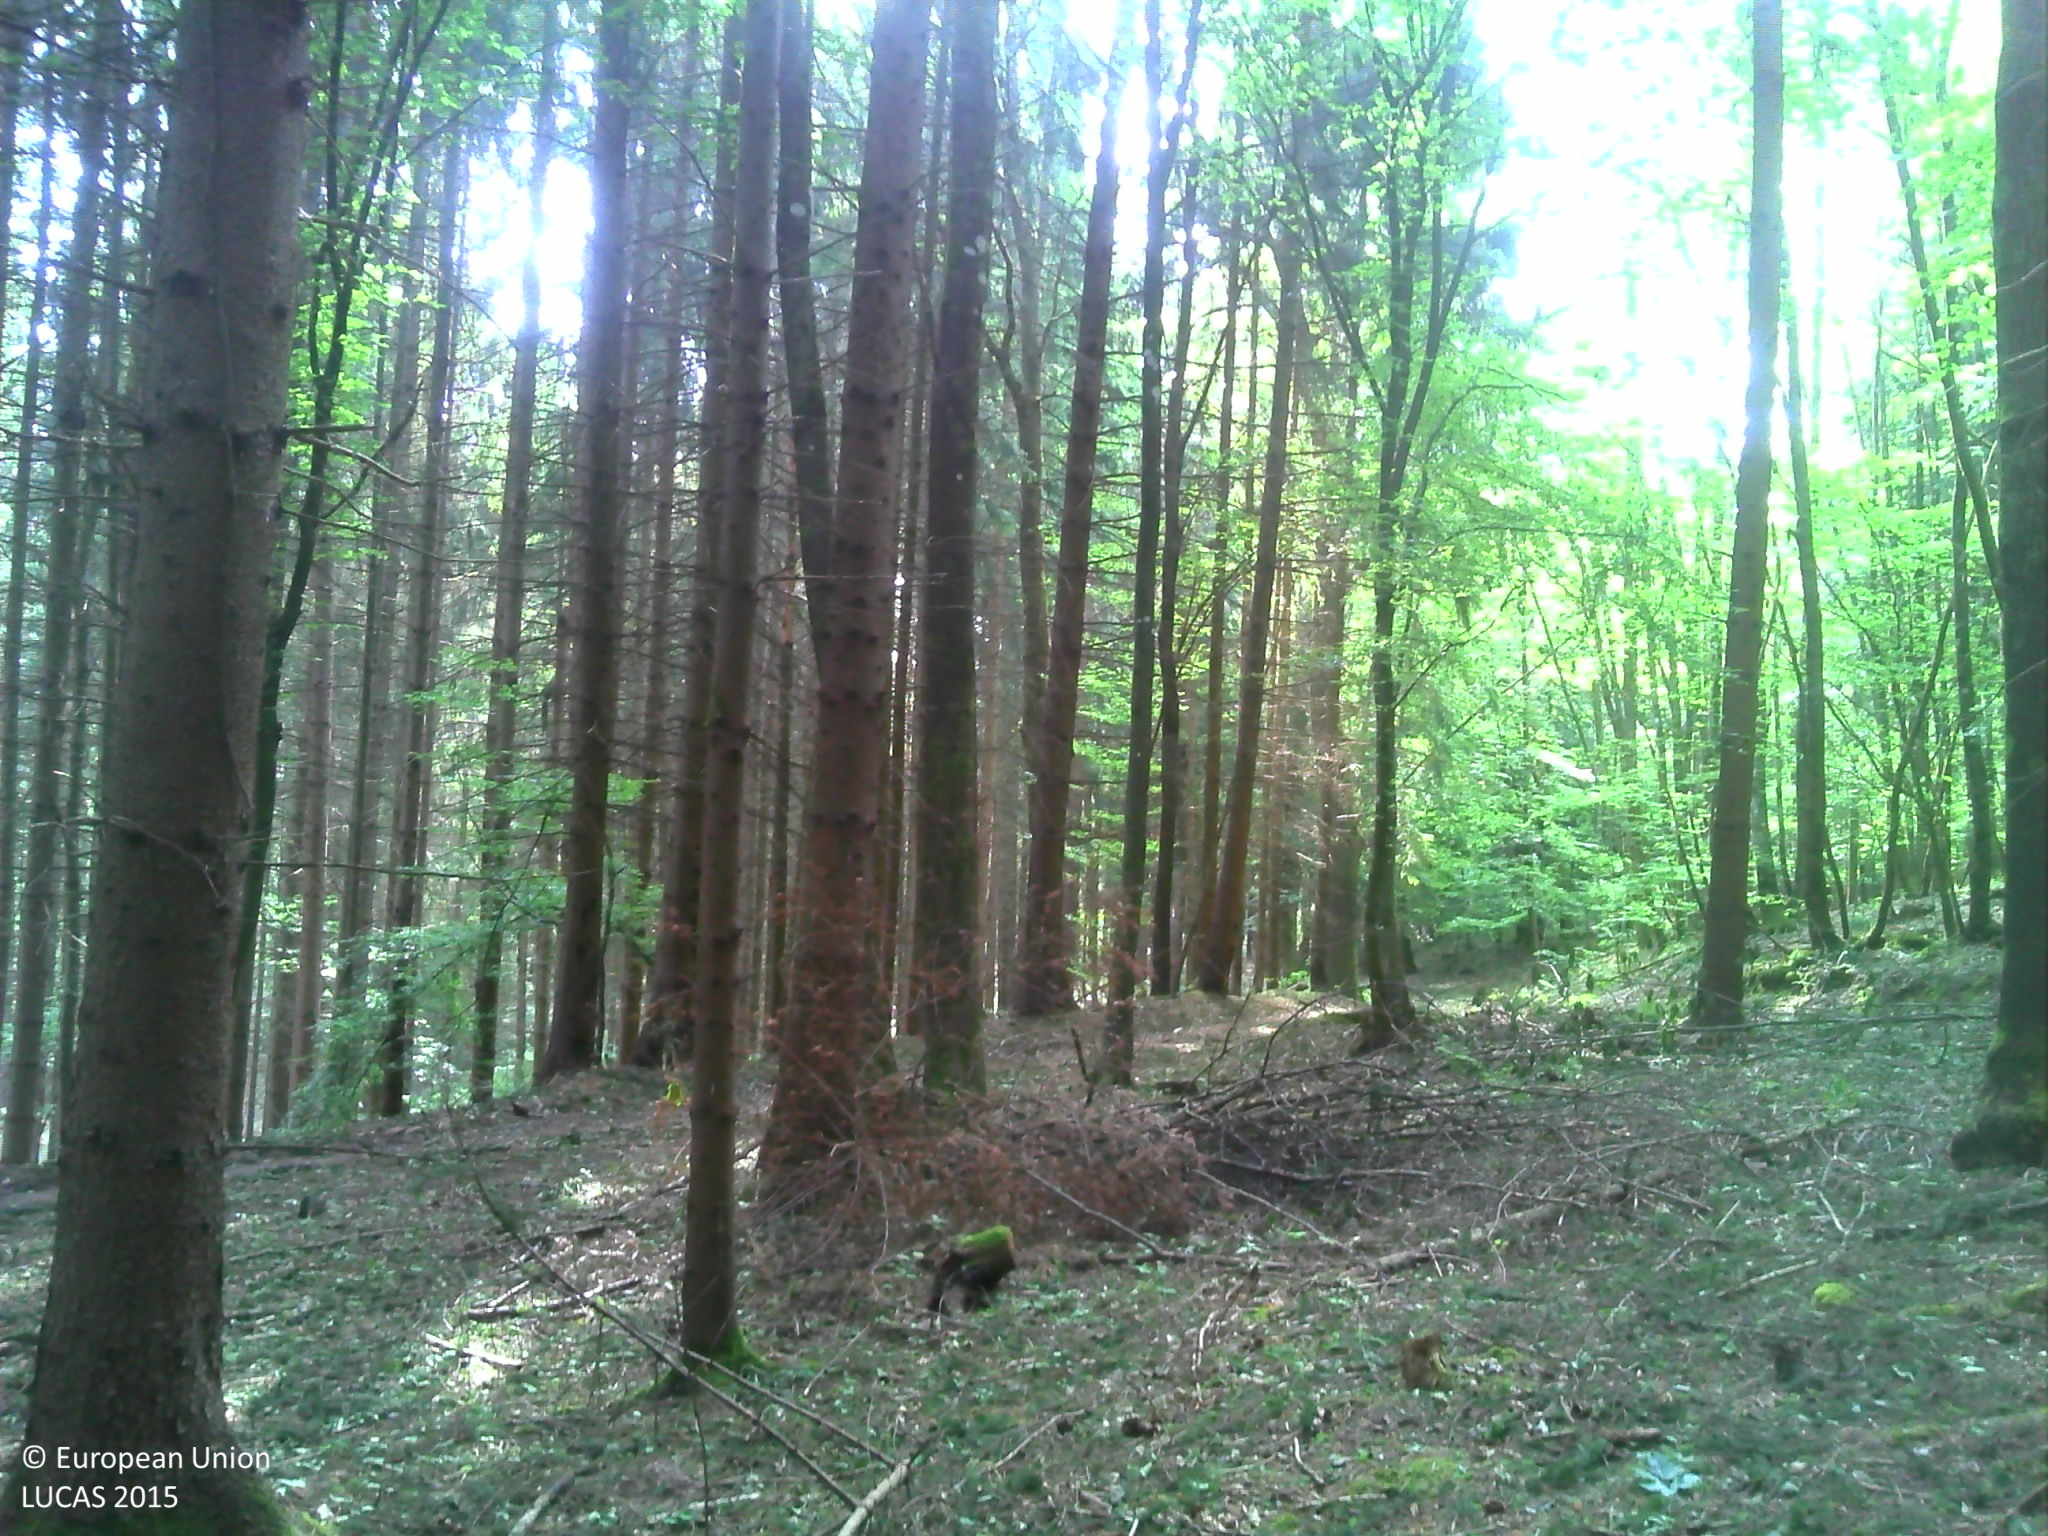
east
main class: Woodland
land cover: Spruce dominated mixed woodland
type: mountainous beech forest
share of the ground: > 75 %
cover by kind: coniferous forest trees 70 %, broadleaved forest trees 30 %
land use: Forestry
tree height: > 5 m
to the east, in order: Spruce dominated mixed woodland; Tracks; Spruce dominated mixed woodland; Tracks
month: May
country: FR
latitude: 48.3170
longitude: 7.3174
